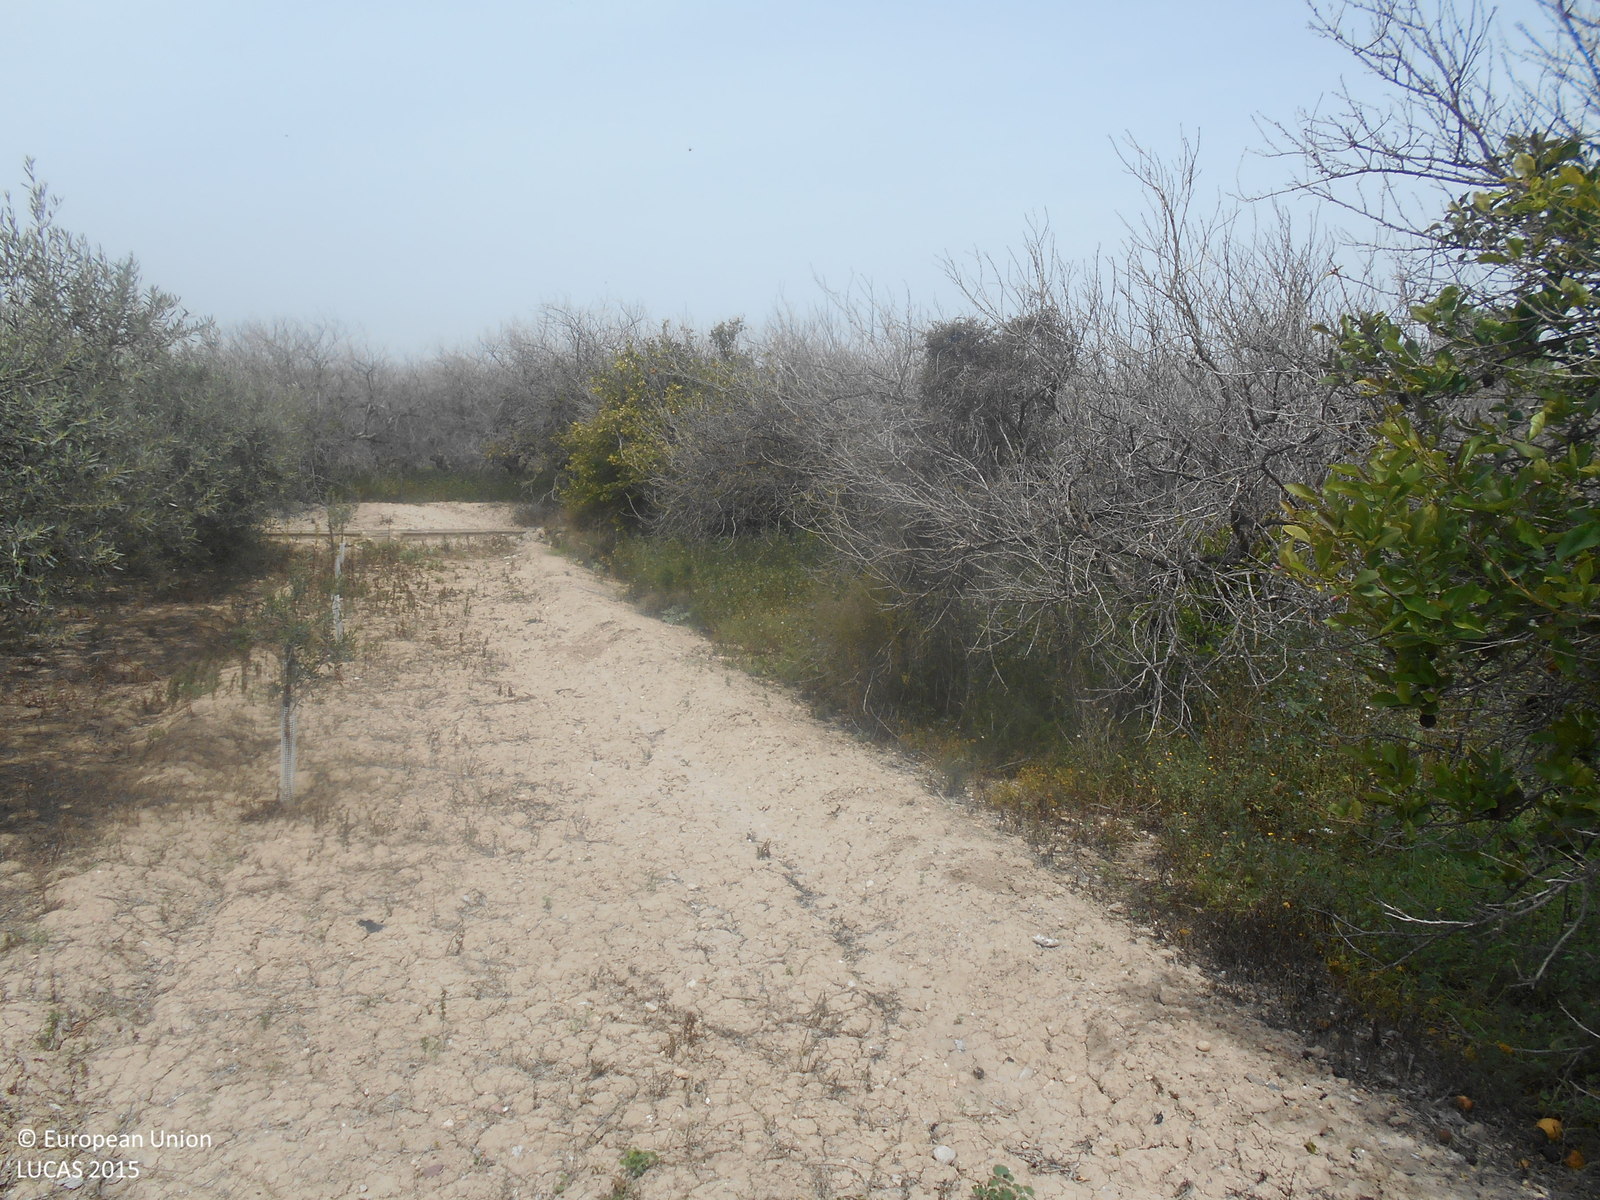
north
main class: Cropland
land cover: Olive groves
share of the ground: 10 - 25 %
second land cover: Other bare soil
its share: > 75 %
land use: Agriculture (excluding fallow land and kitchen gardens)
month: April
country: ES
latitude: 37.8897
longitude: -1.3432
